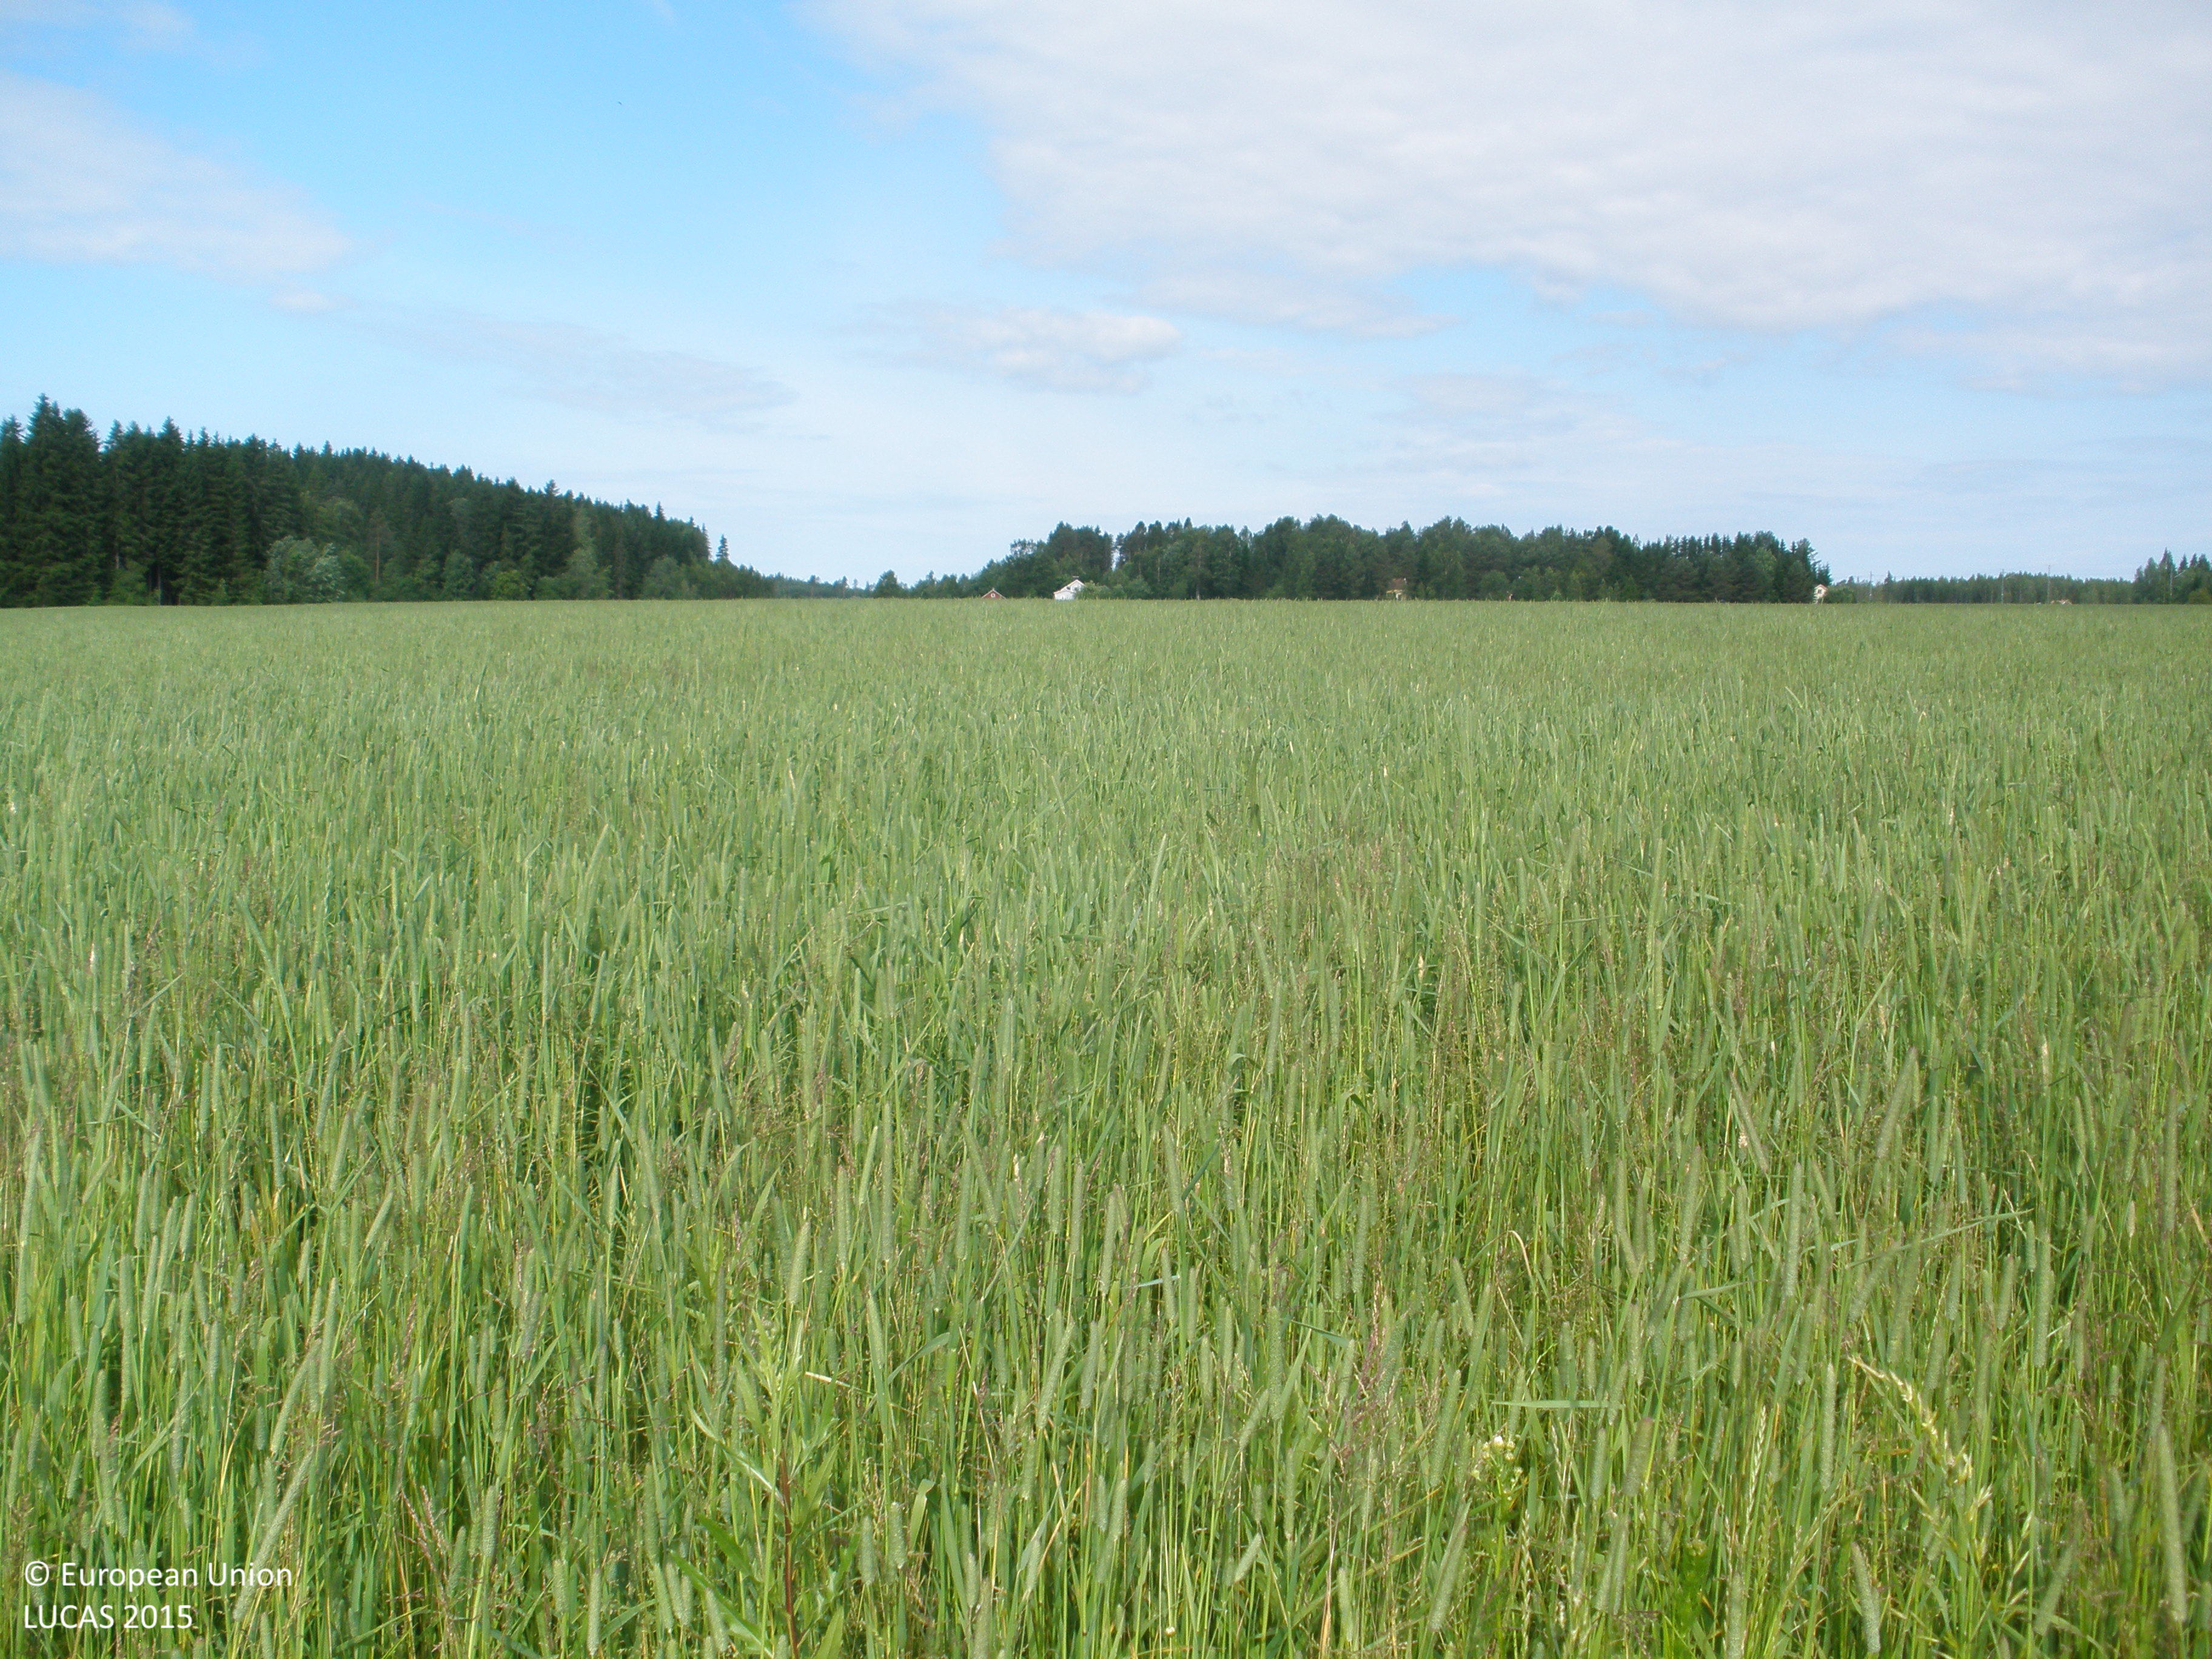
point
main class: Cropland
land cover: Mixed cereals for fodder
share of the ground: > 75 %
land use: Agriculture (excluding fallow land and kitchen gardens)
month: July
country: FI
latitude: 60.8731
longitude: 23.2107
